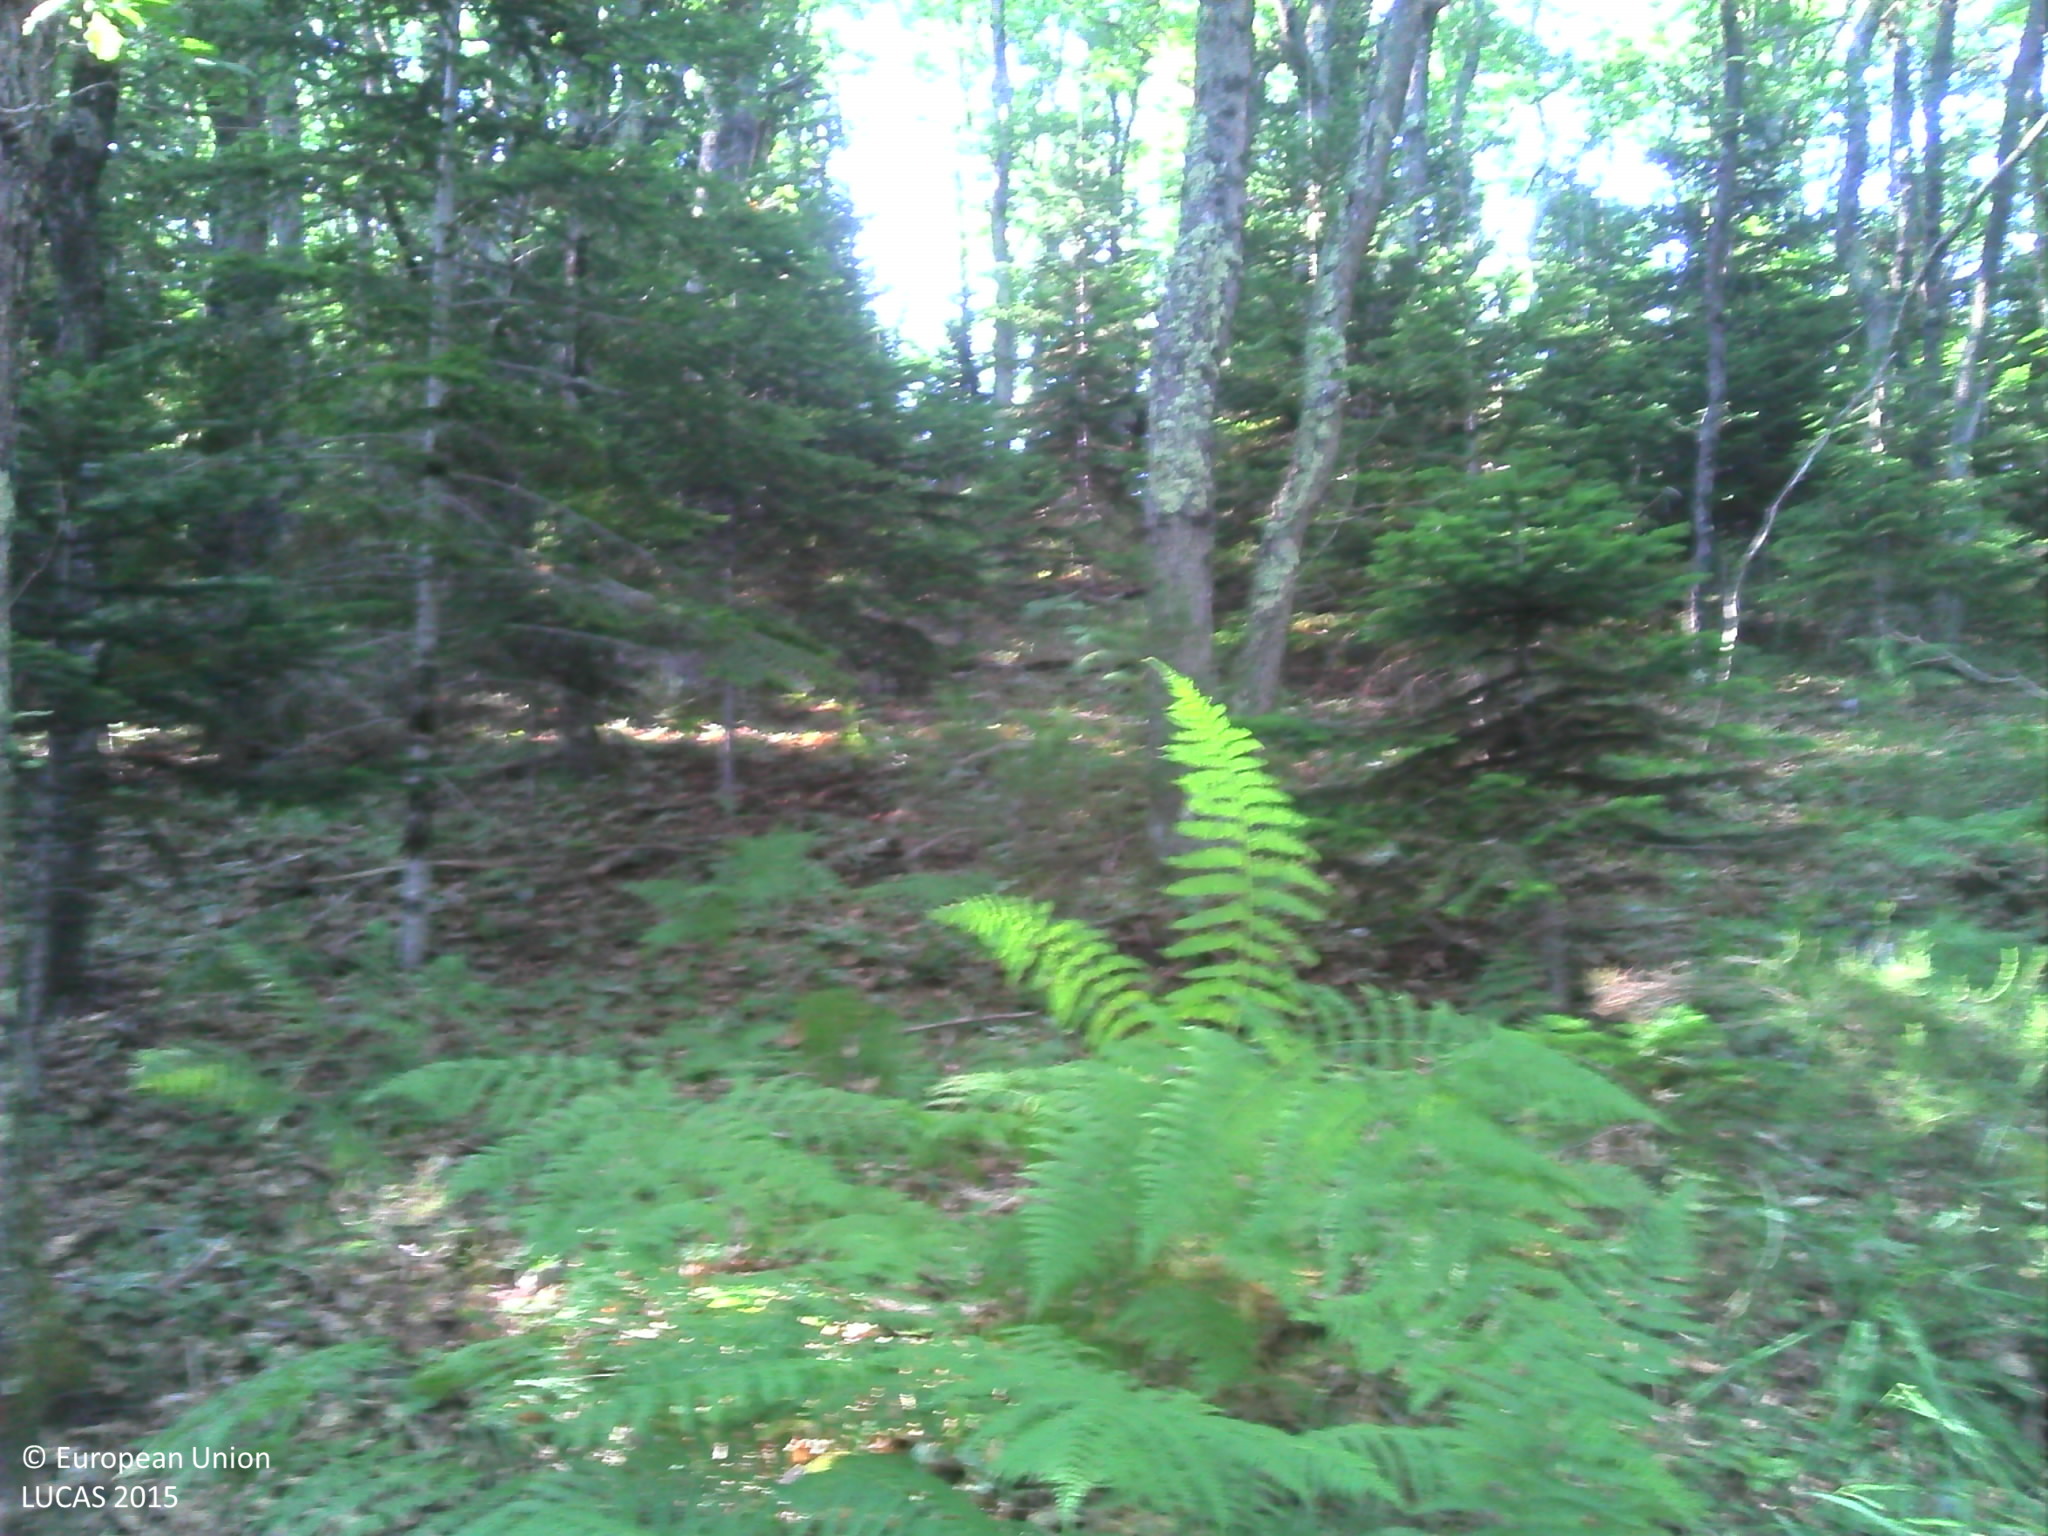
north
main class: Woodland
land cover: Broadleaved woodland
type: thermophilous deciduous forest
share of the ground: > 75 %
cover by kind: broadleaved forest trees 90 %, herbaceous plants 10 %
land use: Forestry
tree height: > 5 m
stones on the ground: < 10 %
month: July
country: FR
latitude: 42.9259
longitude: 2.1063
